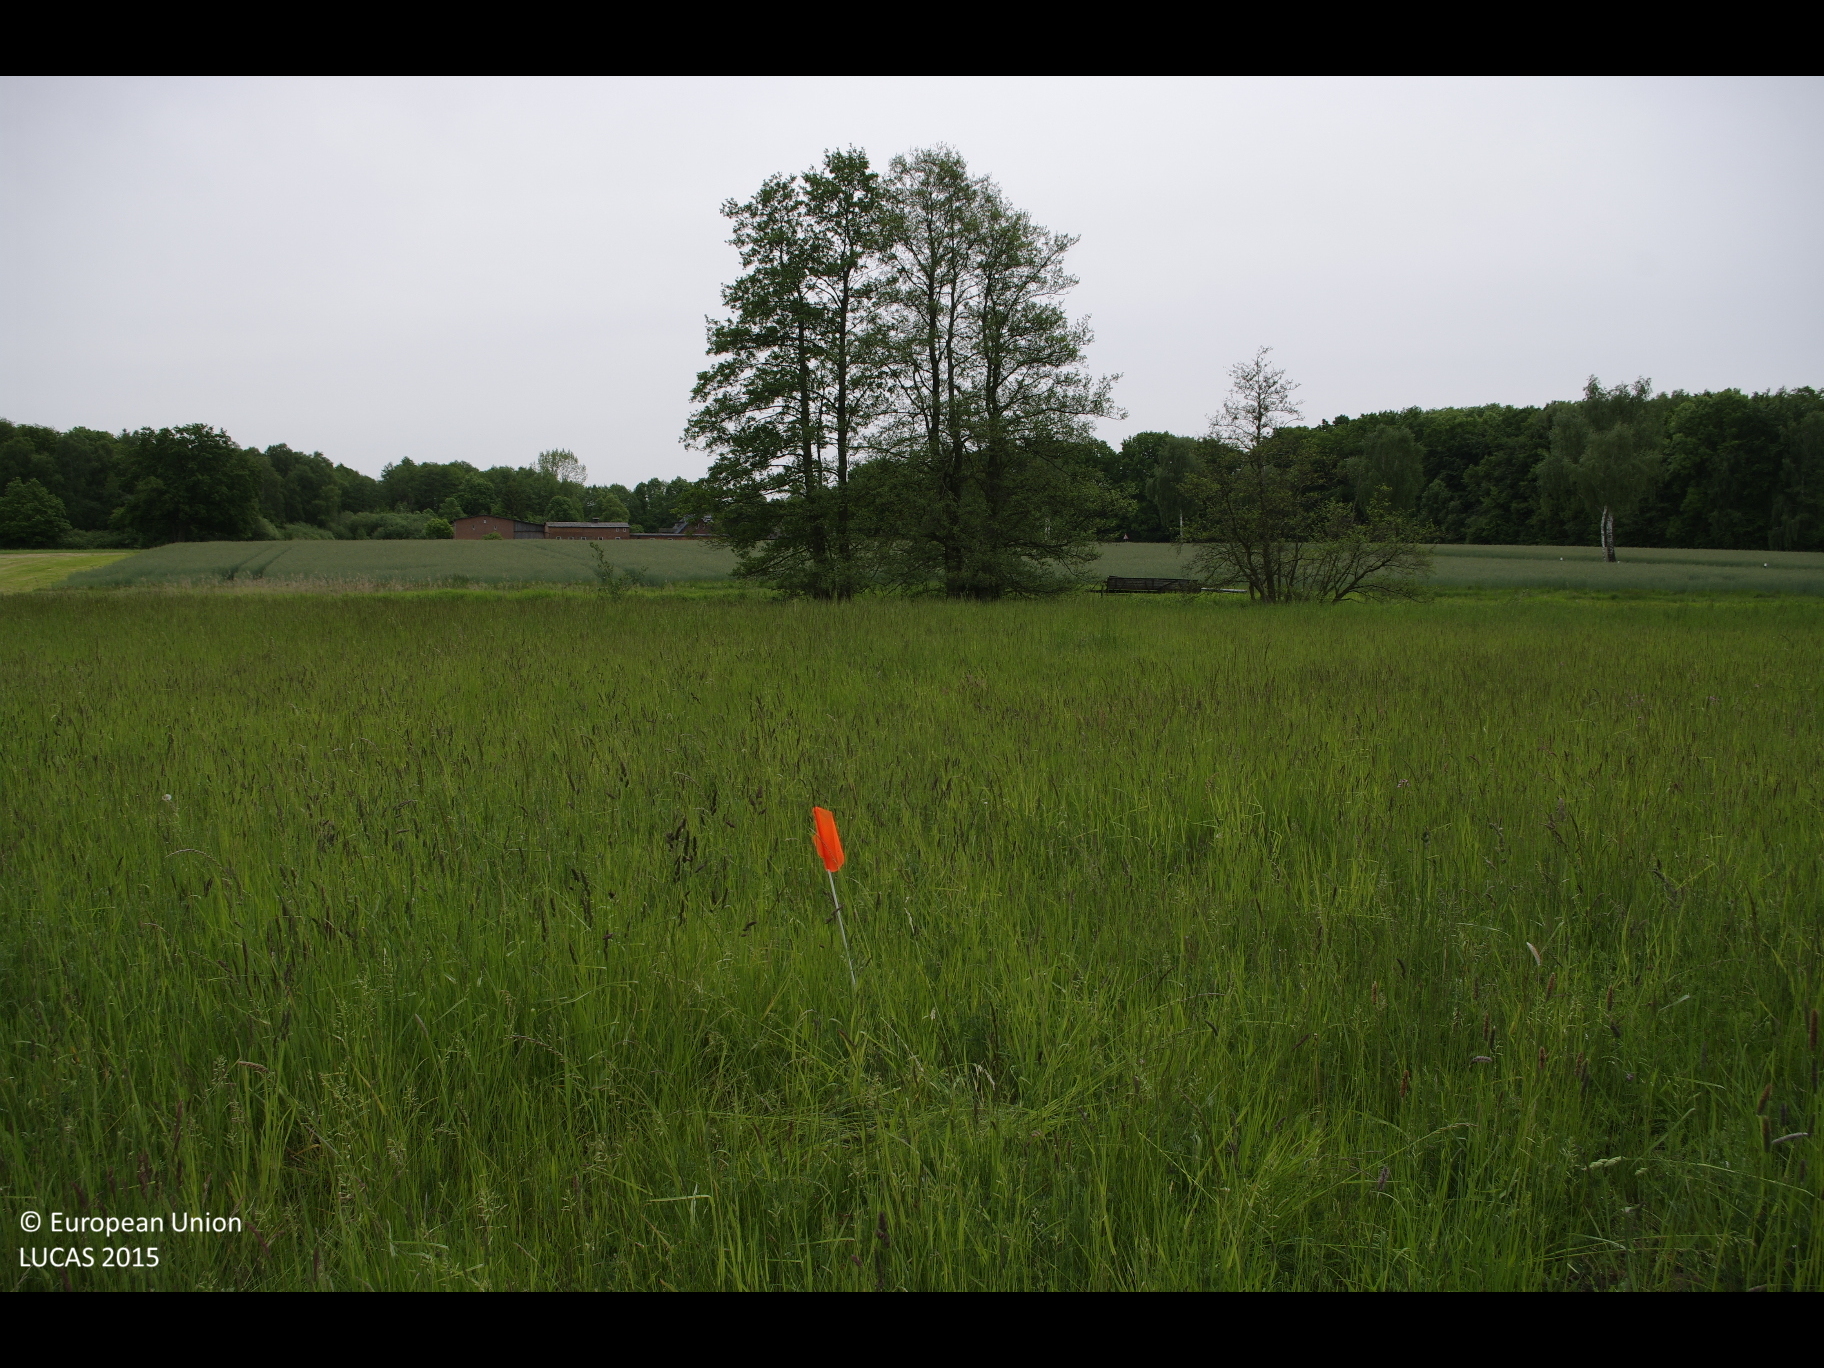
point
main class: Grassland
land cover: Grassland without tree/shrub cover
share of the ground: > 75 %
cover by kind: herbaceous plants 80 %, consolidated bare surface 15 %, lichens and mosses 5 %
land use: Agriculture (excluding fallow land and kitchen gardens)
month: May
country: DE
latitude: 53.0589
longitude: 10.6115
